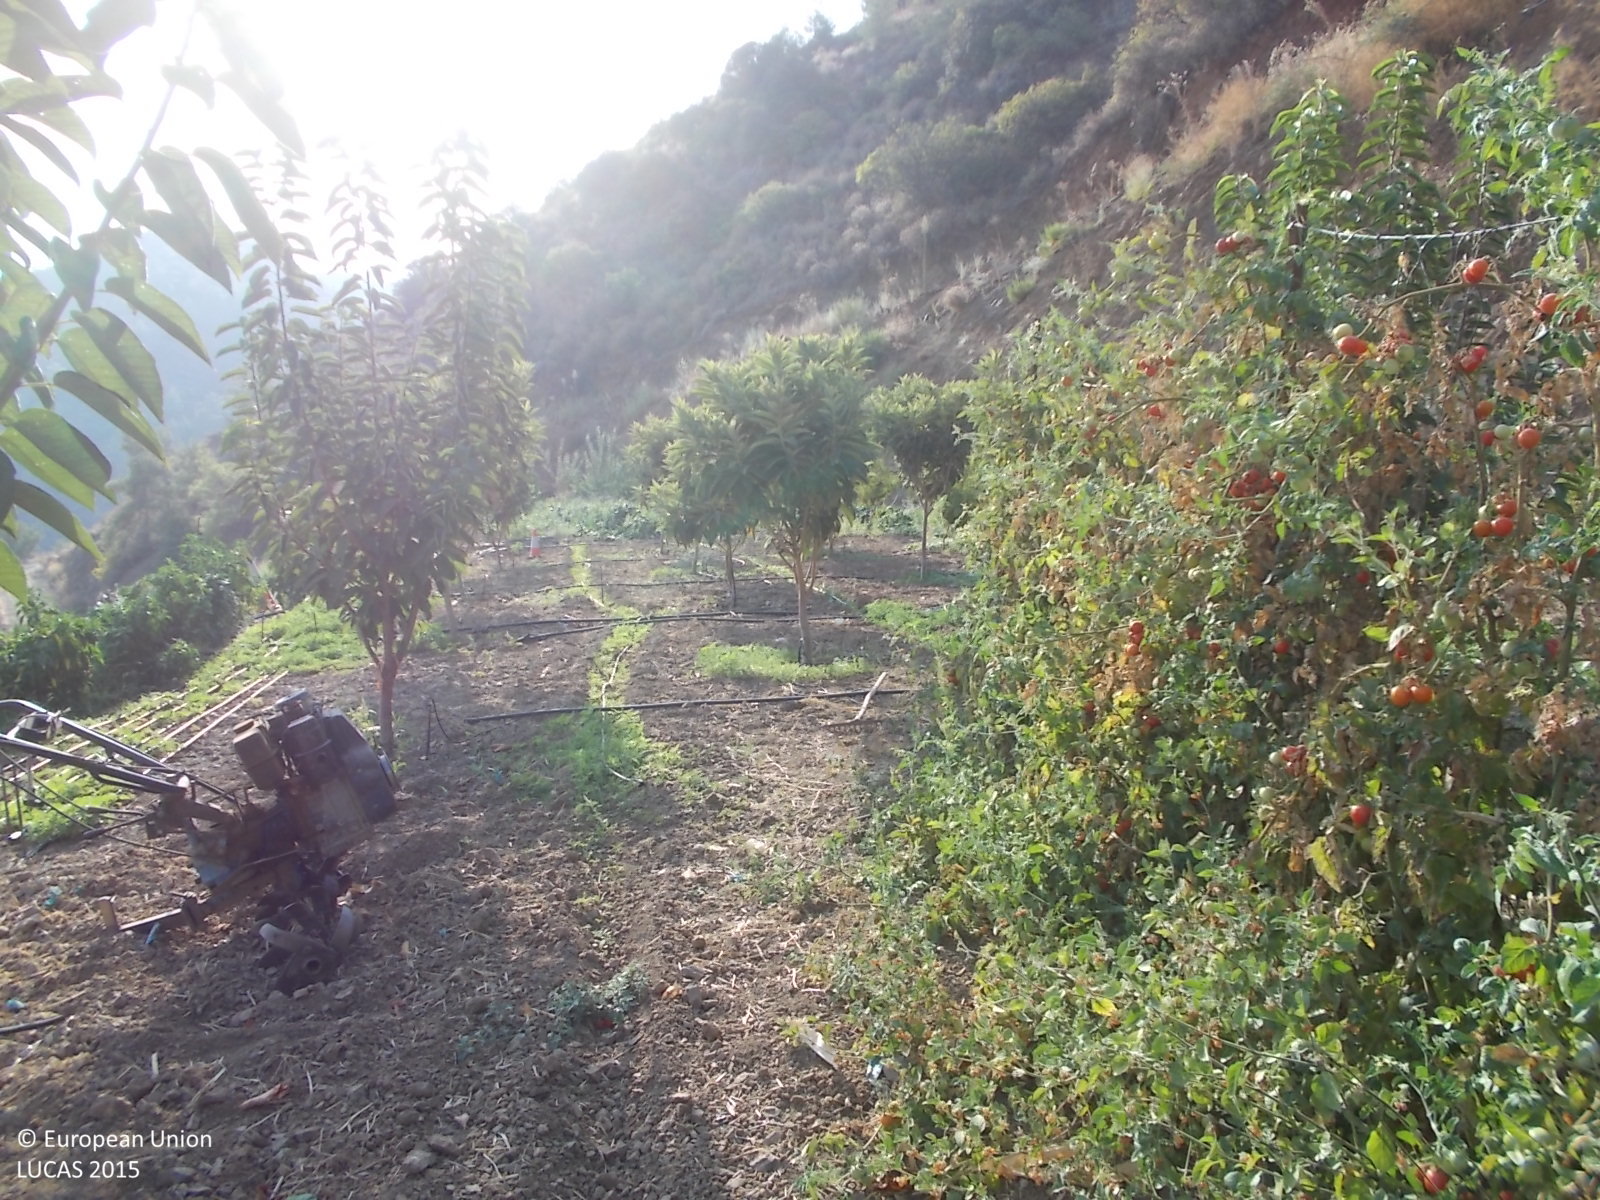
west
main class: Cropland
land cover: Tomatoes
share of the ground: 10 - 25 %
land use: Agriculture (excluding fallow land and kitchen gardens)
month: April
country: CY
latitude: 34.8778
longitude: 33.1849
